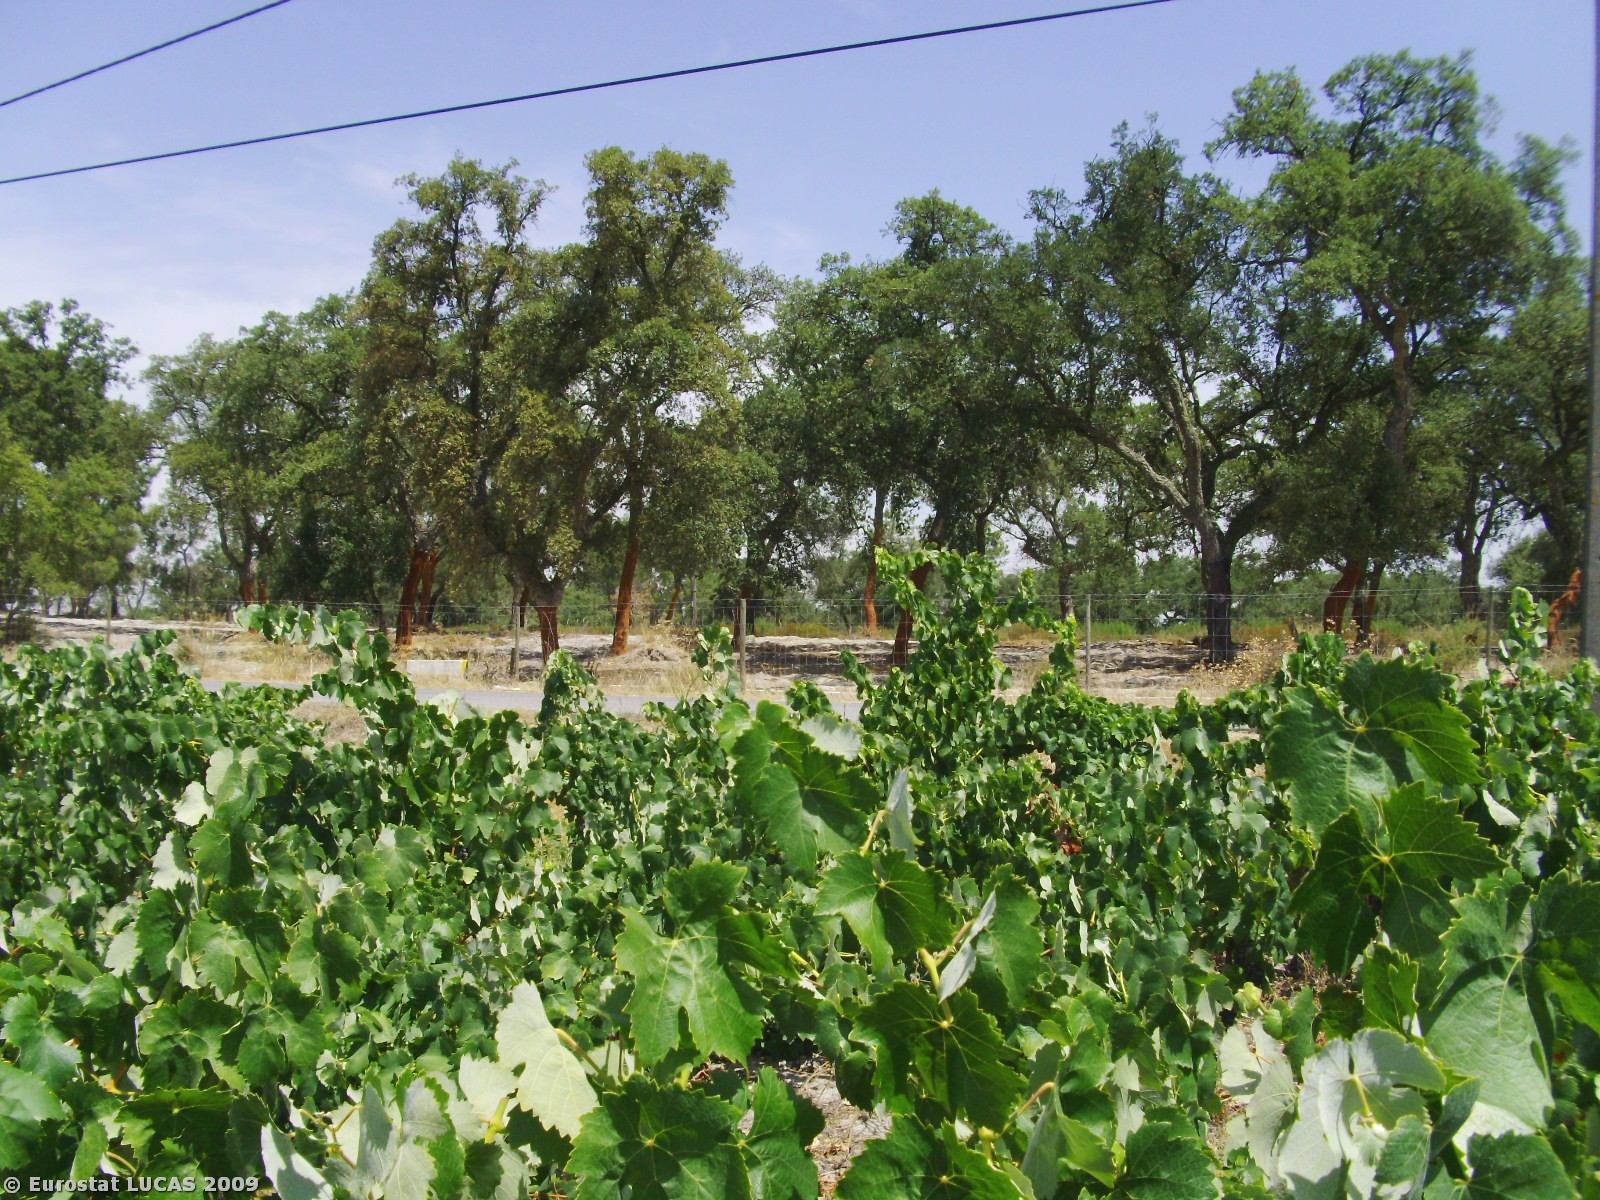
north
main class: Cropland
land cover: Vineyards
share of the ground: 25 - 50 %
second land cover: Spontaneously vegetated surfaces
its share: 50 - 75 %
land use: Agriculture (excluding fallow land and kitchen gardens)
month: July
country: PT
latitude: 38.5735
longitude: -8.8301
